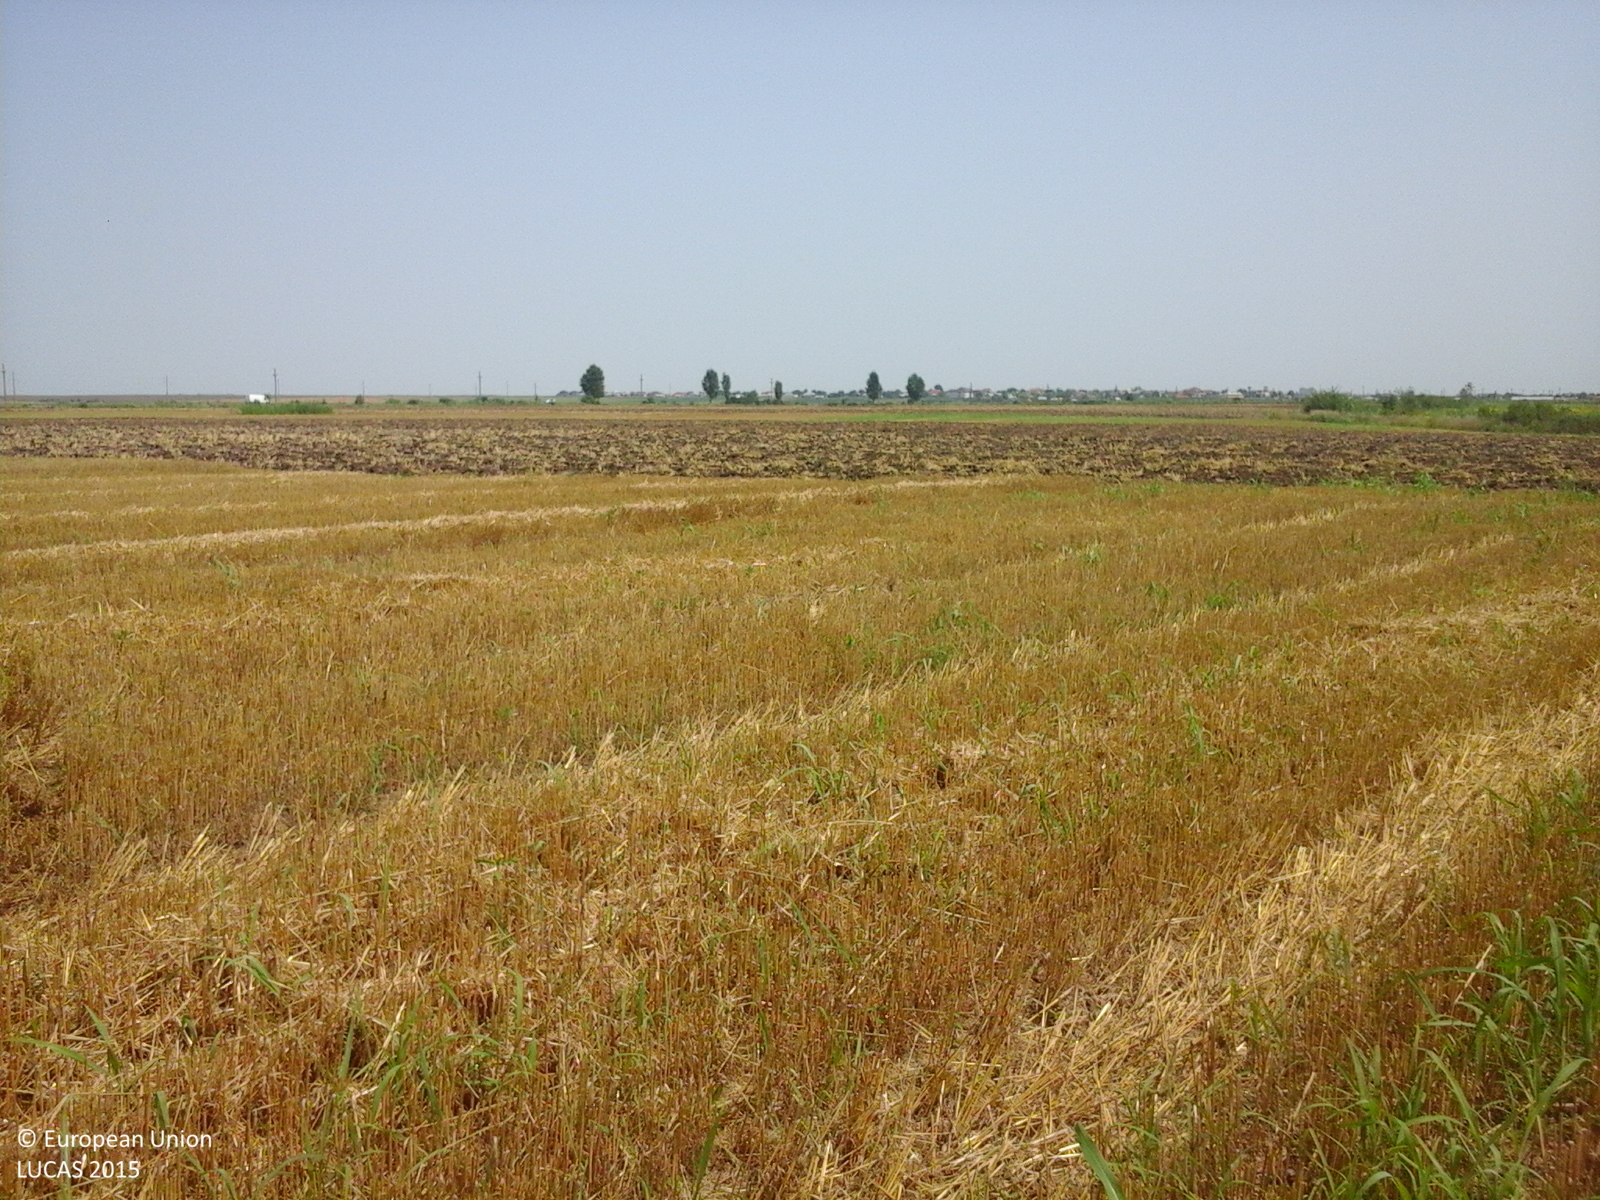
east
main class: Cropland
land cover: Common wheat
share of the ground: 25 - 50 %
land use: Agriculture (excluding fallow land and kitchen gardens)
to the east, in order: Common wheat
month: July
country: RO
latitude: 44.7343
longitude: 26.5738
